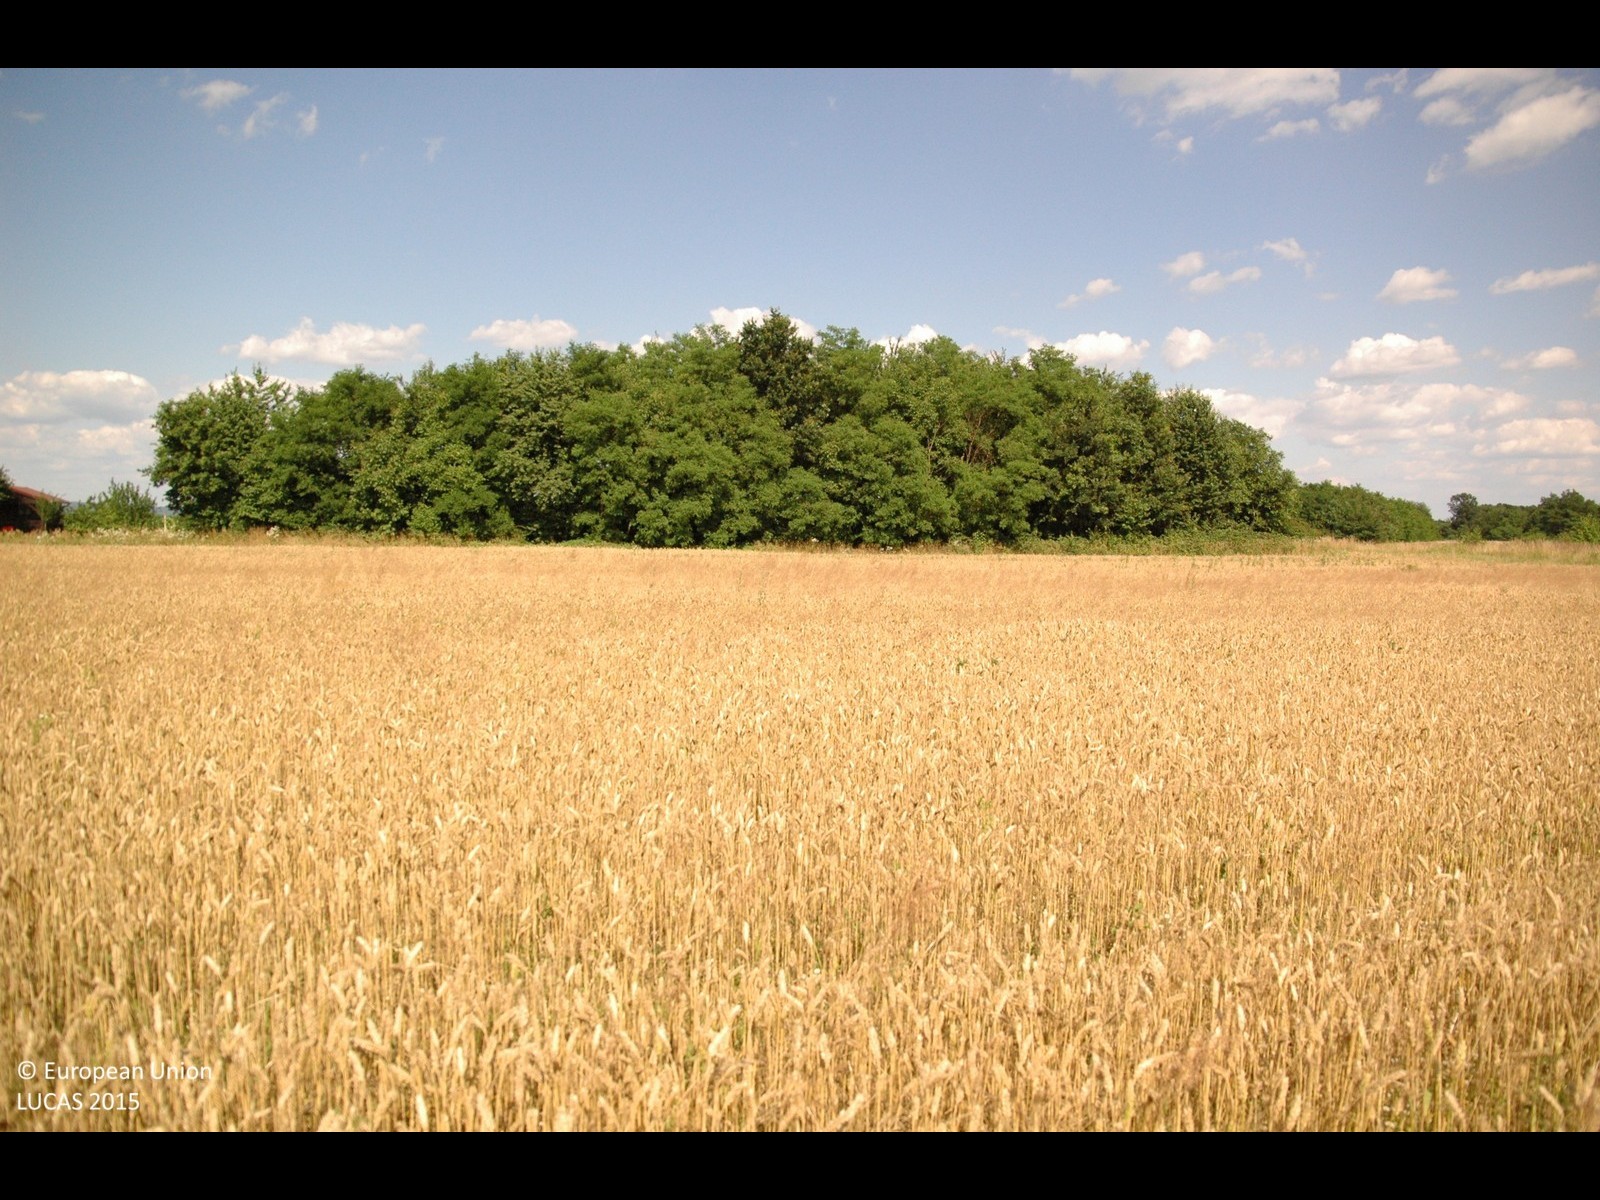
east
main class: Cropland
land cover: Common wheat
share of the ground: > 75 %
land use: Agriculture (excluding fallow land and kitchen gardens)
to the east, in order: Common wheat; Broadleaved woodland; Tracks; Grassland without tree/shrub cover; Common wheat; Maize
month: June
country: HR
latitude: 46.4021
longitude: 16.5696
